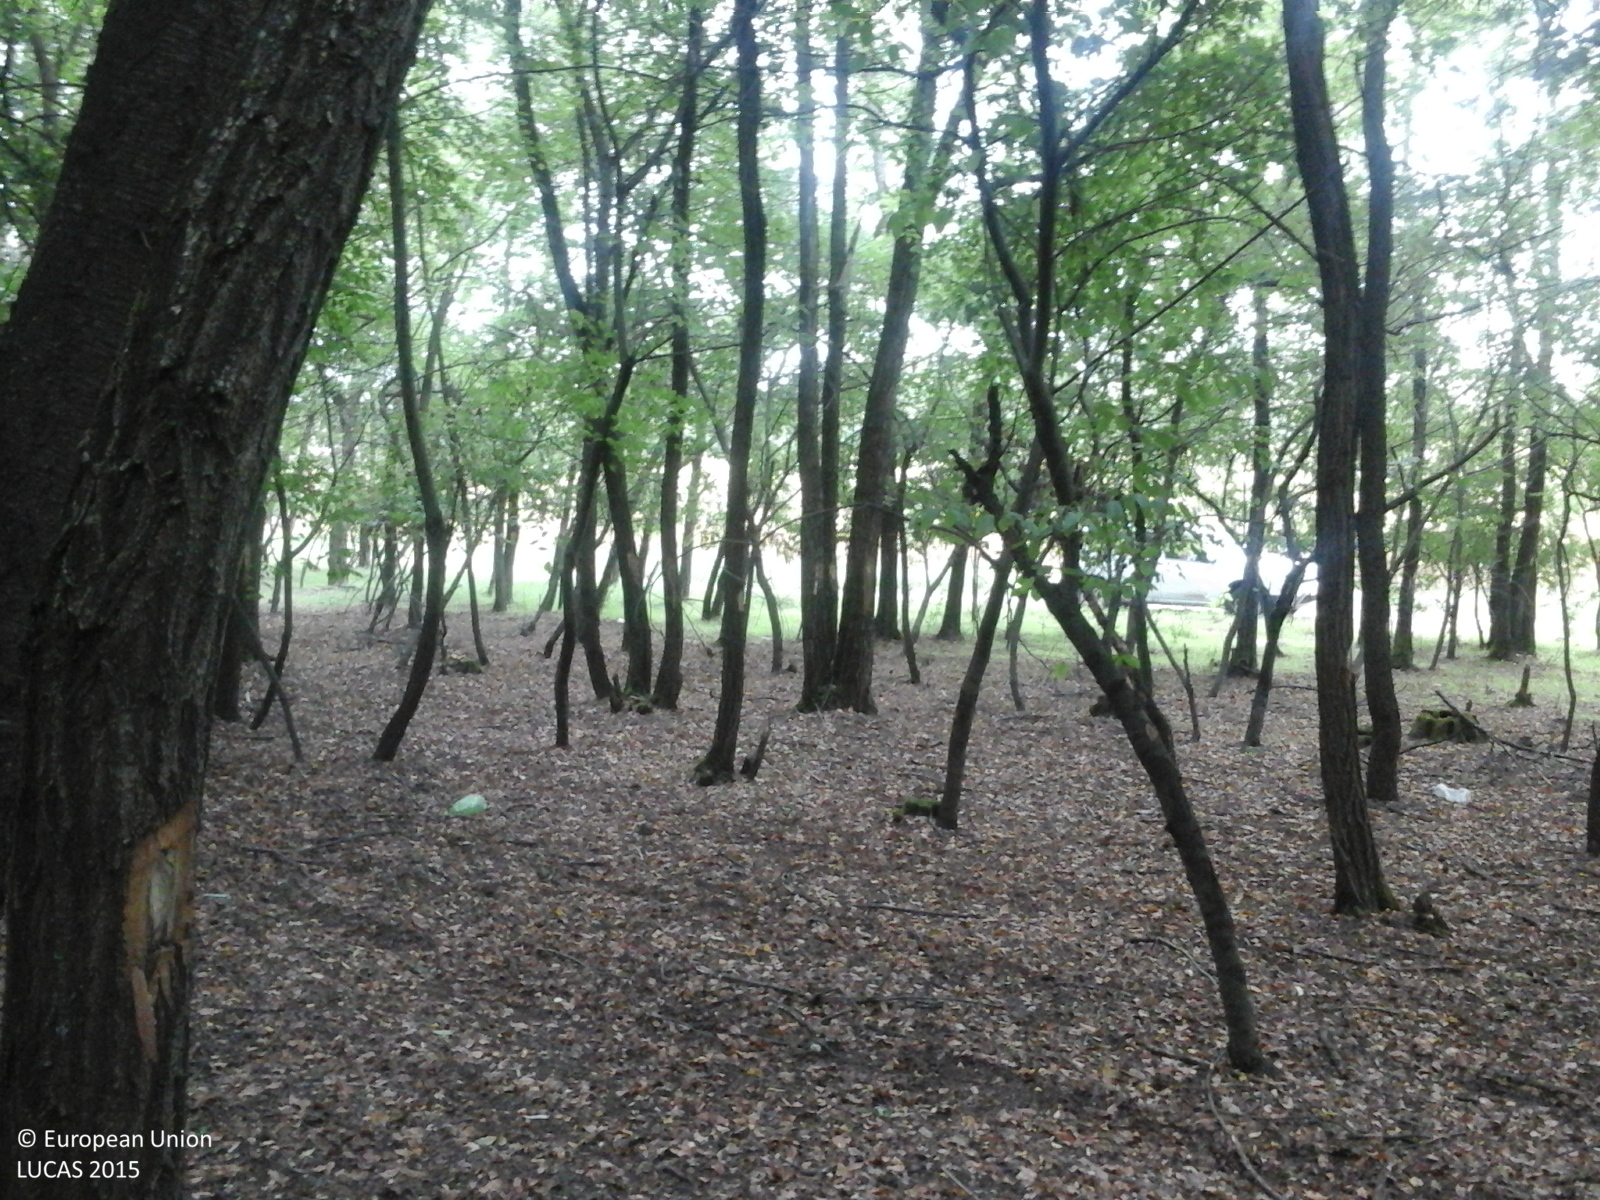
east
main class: Woodland
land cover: Broadleaved woodland
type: exotic forest
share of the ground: > 75 %
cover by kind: broadleaved forest trees 100 %
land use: Forestry
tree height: > 5 m
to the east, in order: Broadleaved woodland; Tracks; Grass margins; Maize; Abandoned hedges; Ditches and canals; Abandoned hedges; Common wheat; Maize; Lucerne
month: September
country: RO
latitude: 47.5035
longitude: 22.0654
